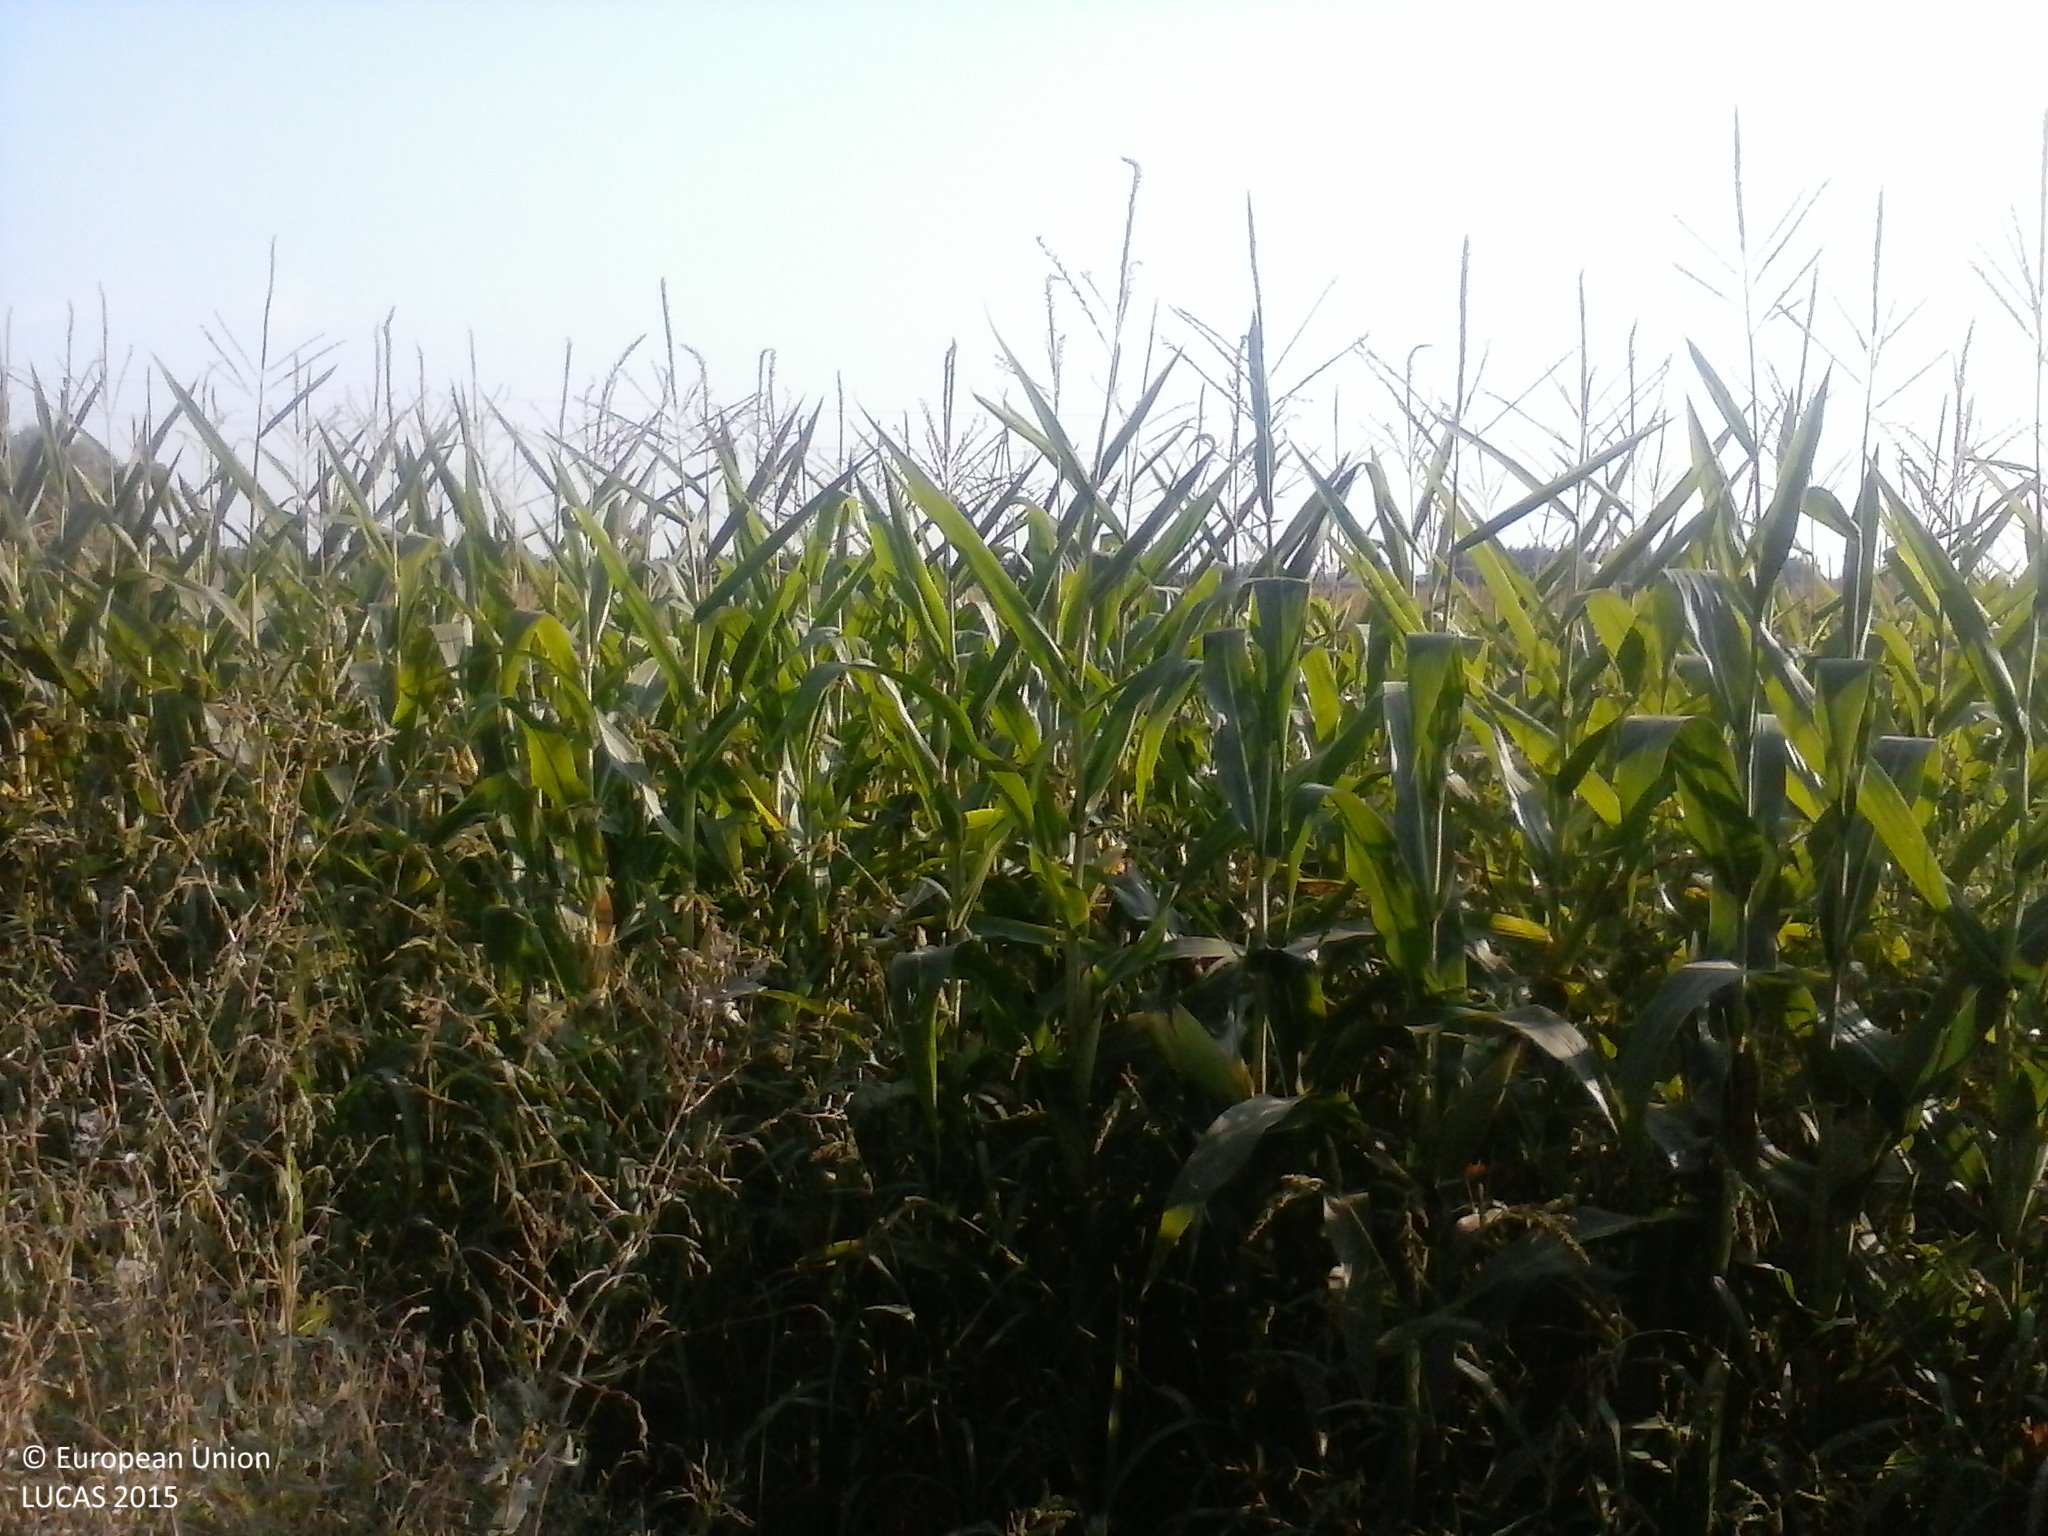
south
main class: Cropland
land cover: Maize
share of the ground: > 75 %
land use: Agriculture (excluding fallow land and kitchen gardens)
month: August
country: HU
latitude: 45.9037
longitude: 18.0360
